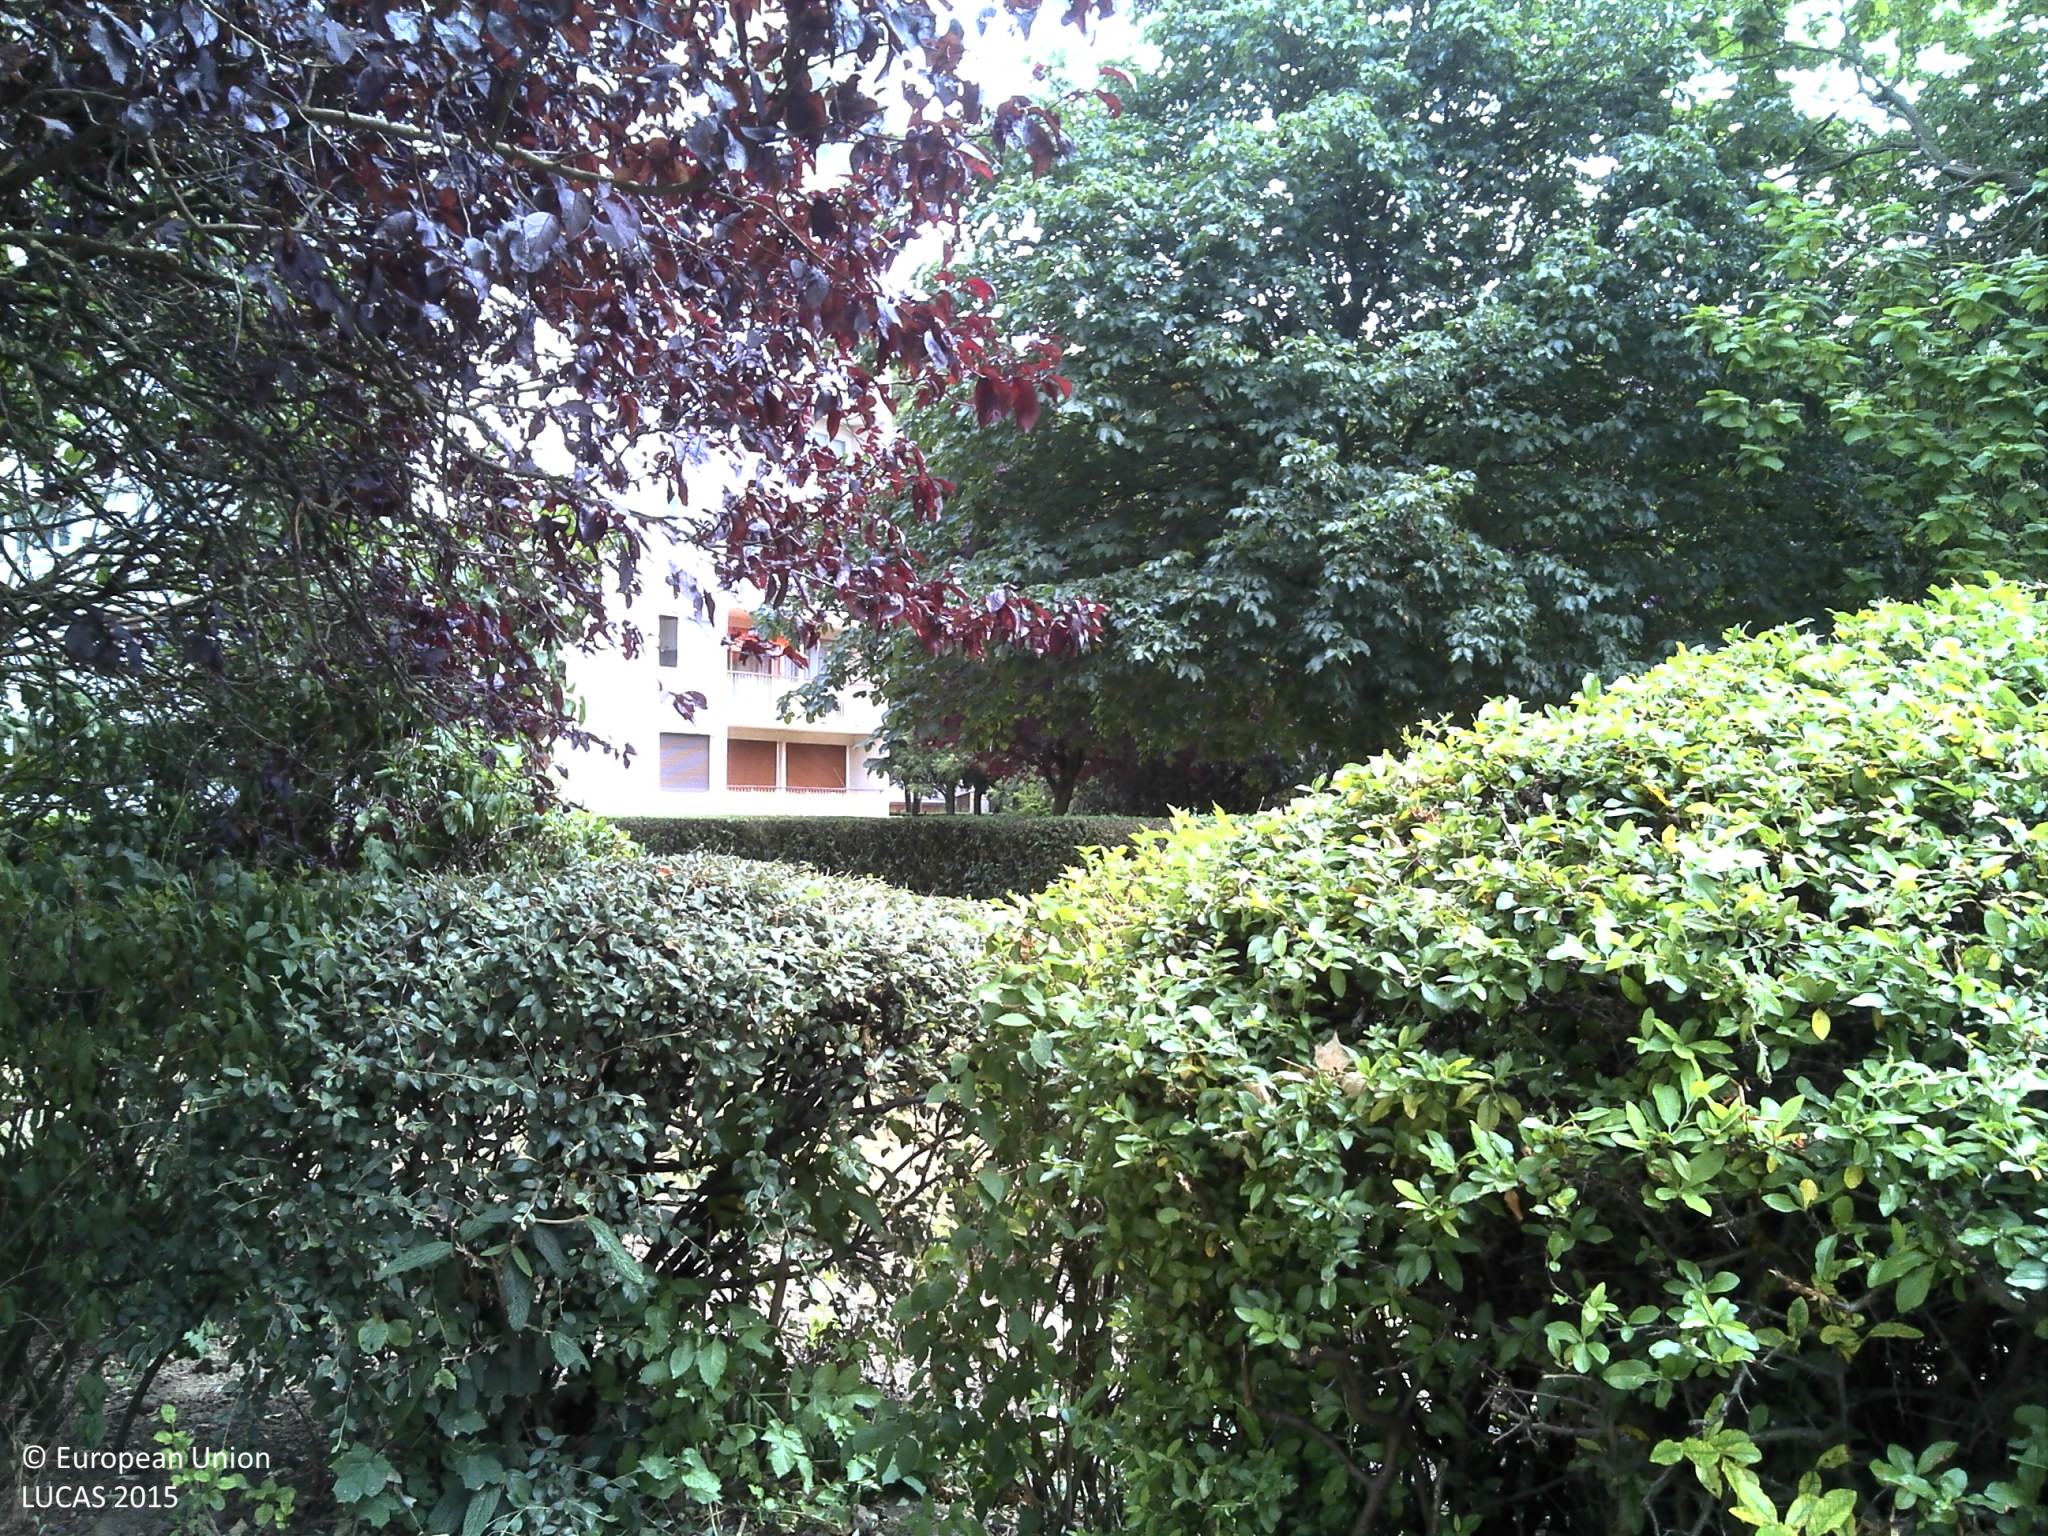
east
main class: Grassland
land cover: Grassland with sparse tree/shrub cover
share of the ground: > 75 %
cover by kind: herbaceous plants 95 %, broadleaved forest trees 5 %
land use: Residential
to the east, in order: Grassland with sparse tree/shrub cover; Artificial constructions in urban areas
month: July
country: FR
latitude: 48.6478
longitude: 2.4011
